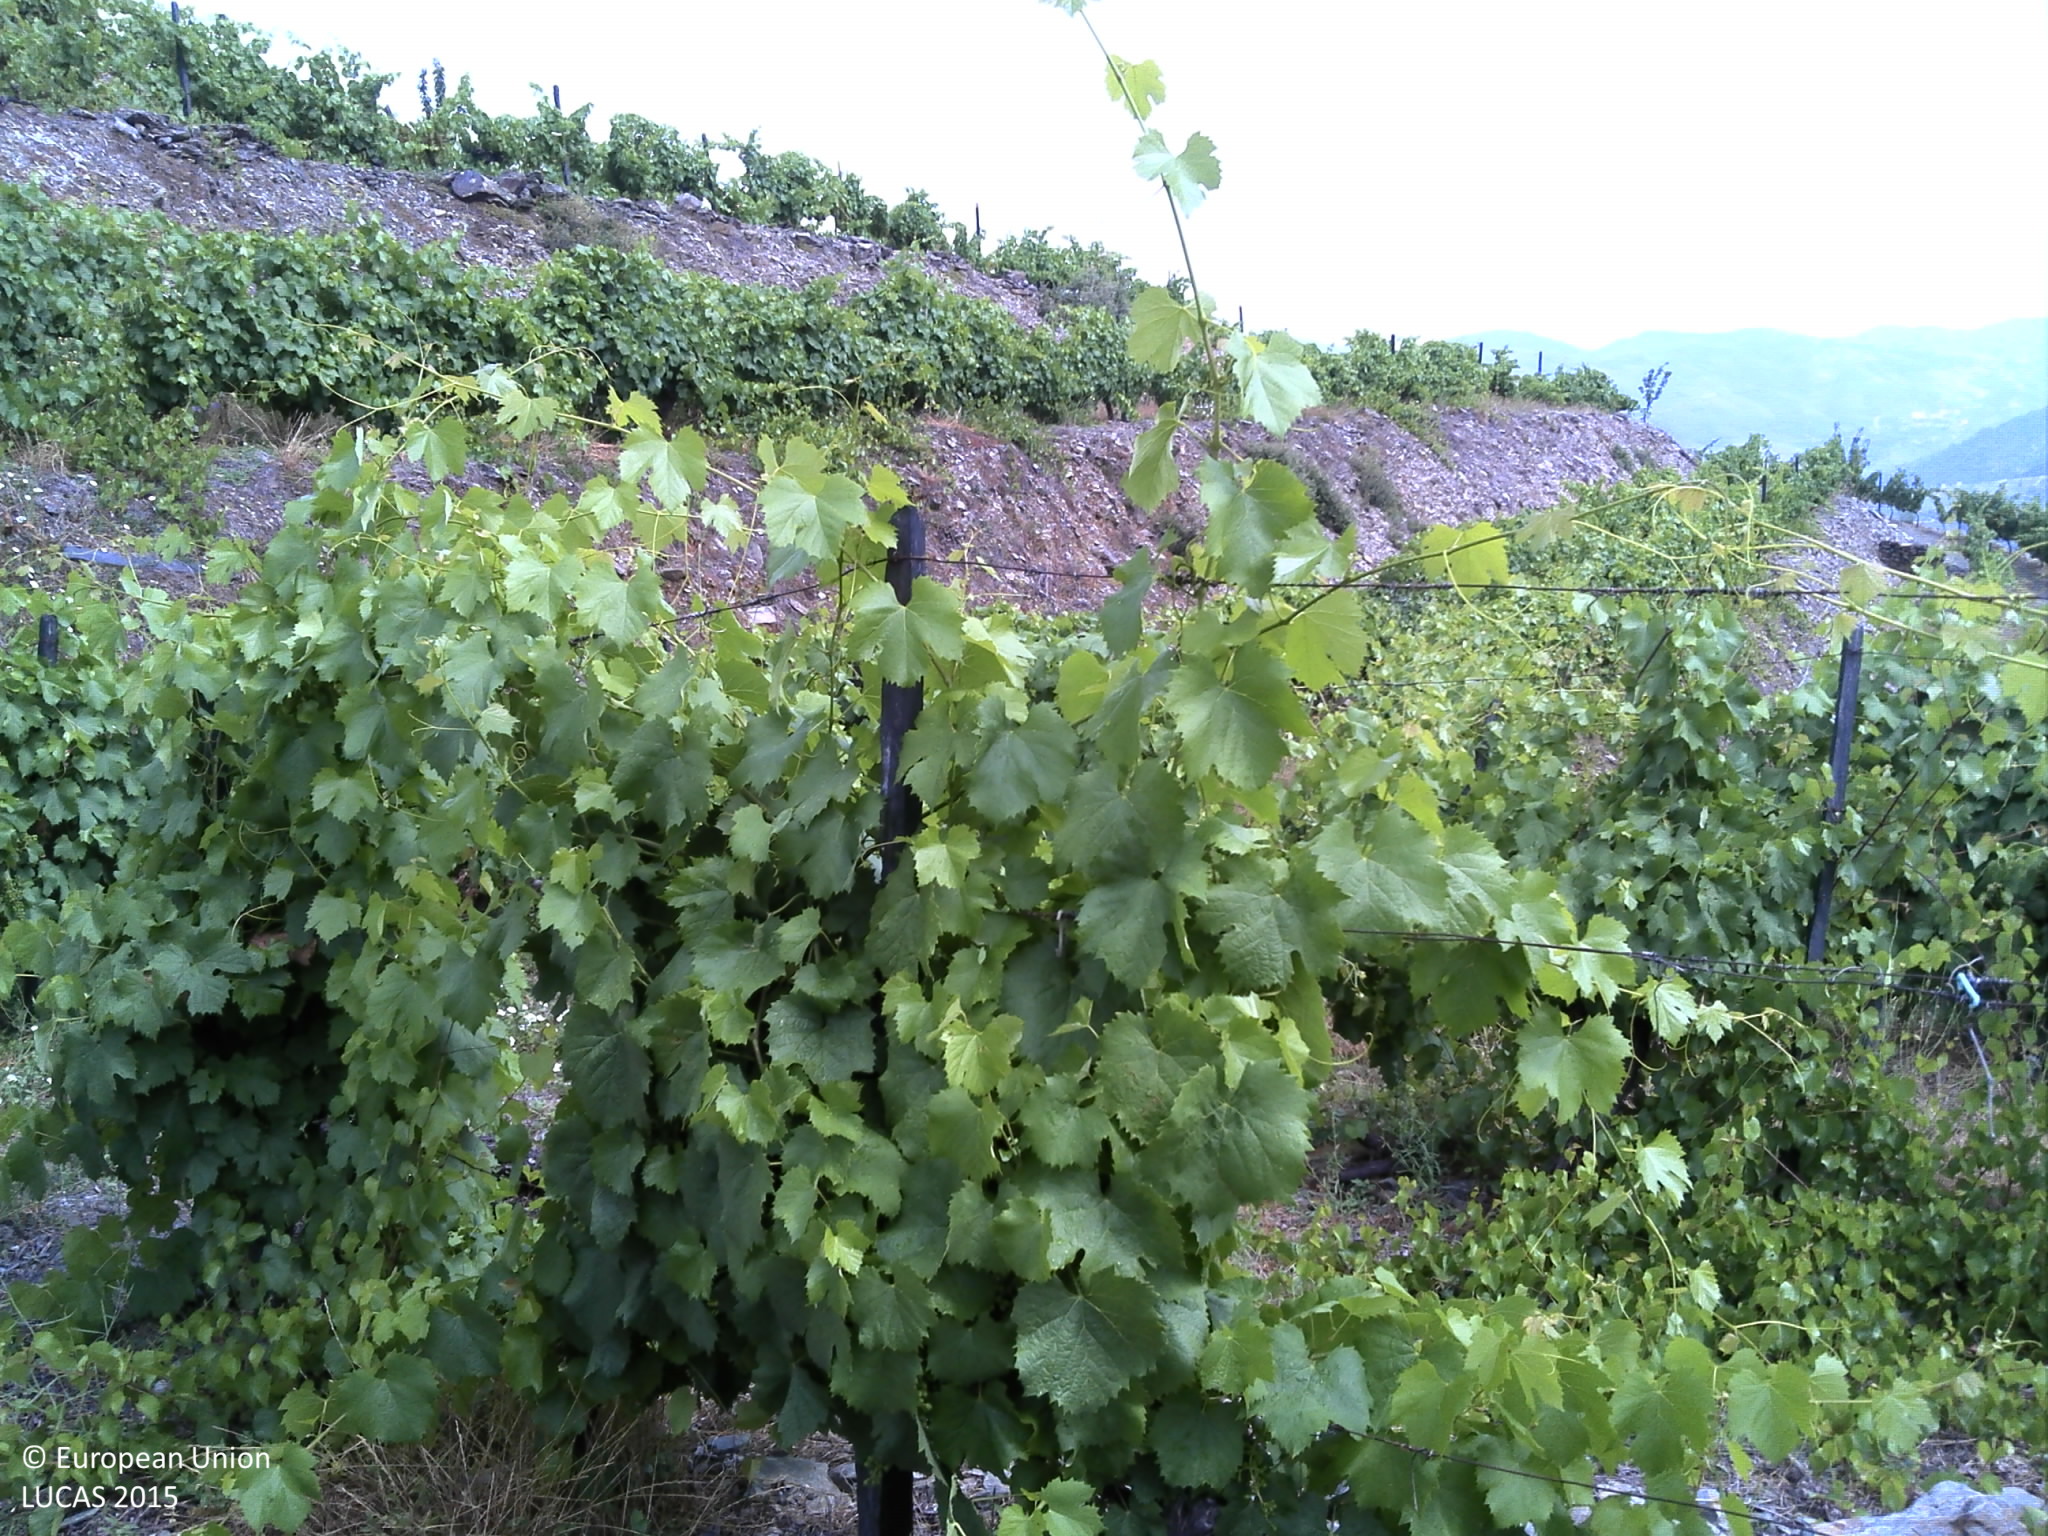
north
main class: Cropland
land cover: Vineyards
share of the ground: < 10 %
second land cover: Spontaneously vegetated surfaces
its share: 10 - 25 %
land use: Agriculture (excluding fallow land and kitchen gardens)
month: June
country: PT
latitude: 41.1686
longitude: -7.4141
